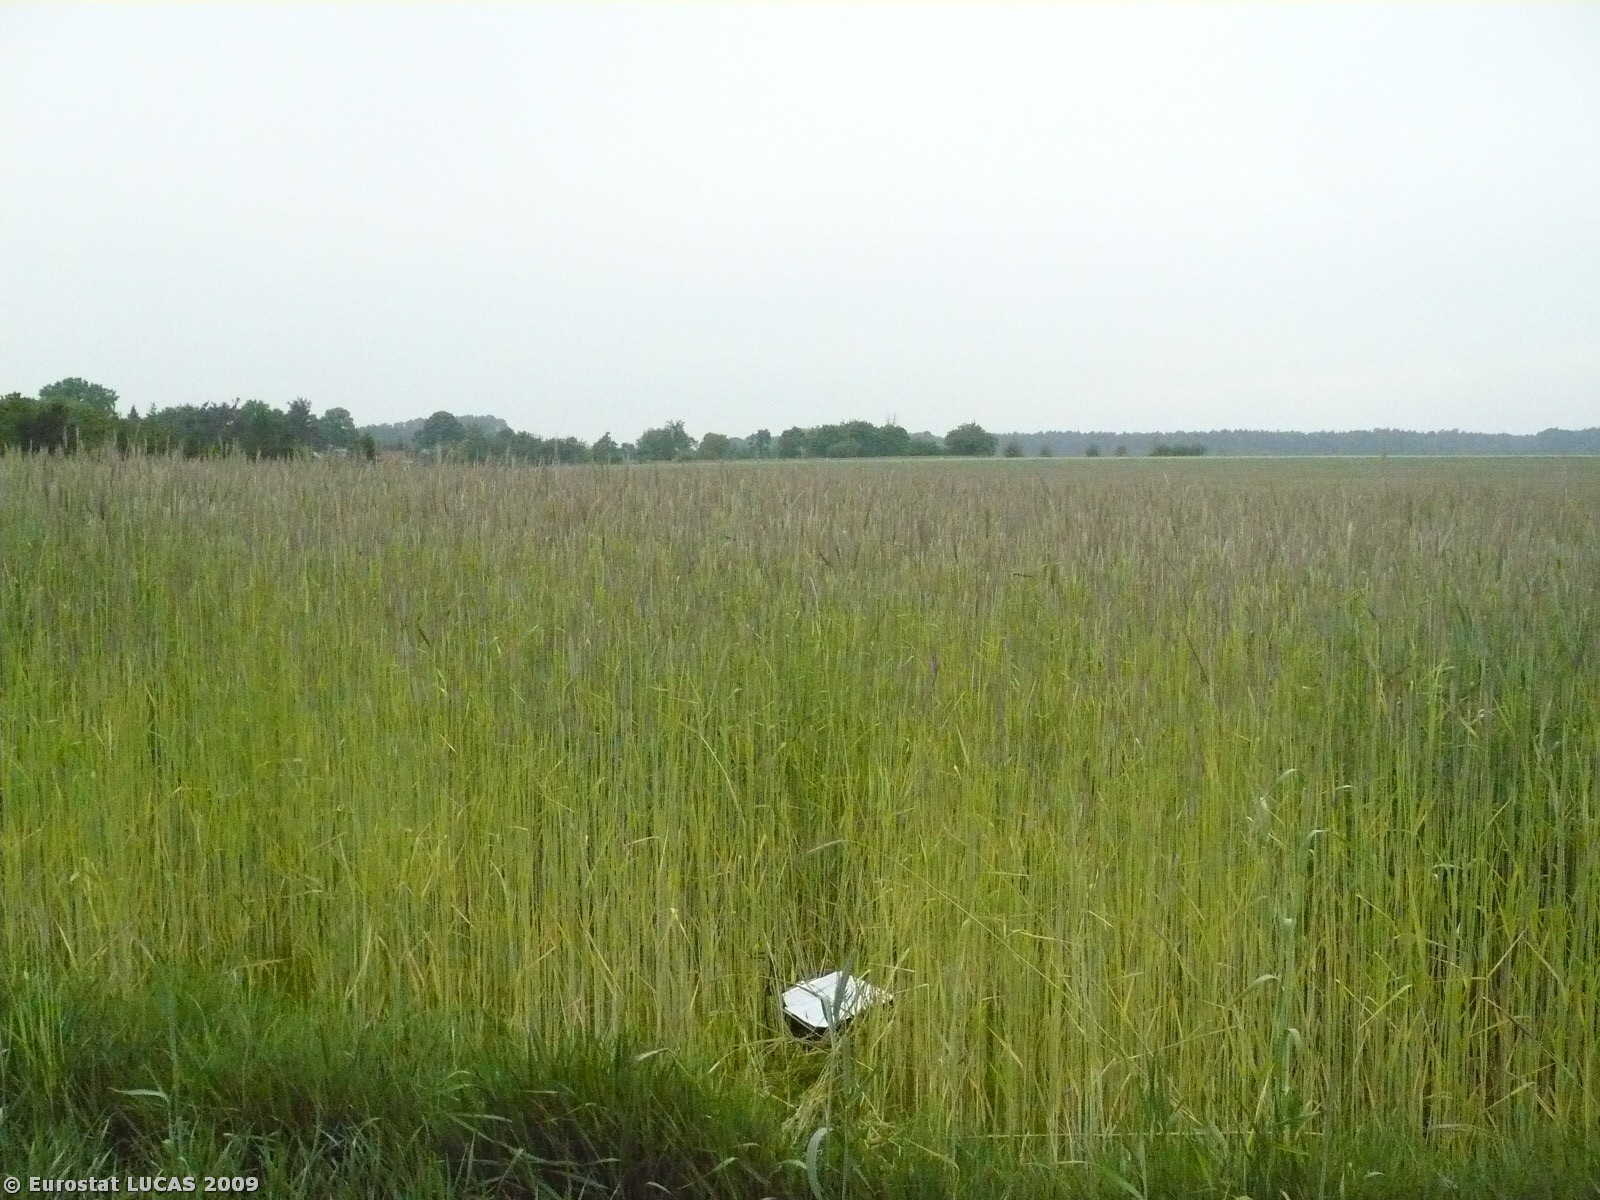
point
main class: Cropland
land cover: Rye
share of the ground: > 75 %
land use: Agriculture (excluding fallow land and kitchen gardens)
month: May
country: PL
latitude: 52.1752
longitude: 16.2800
